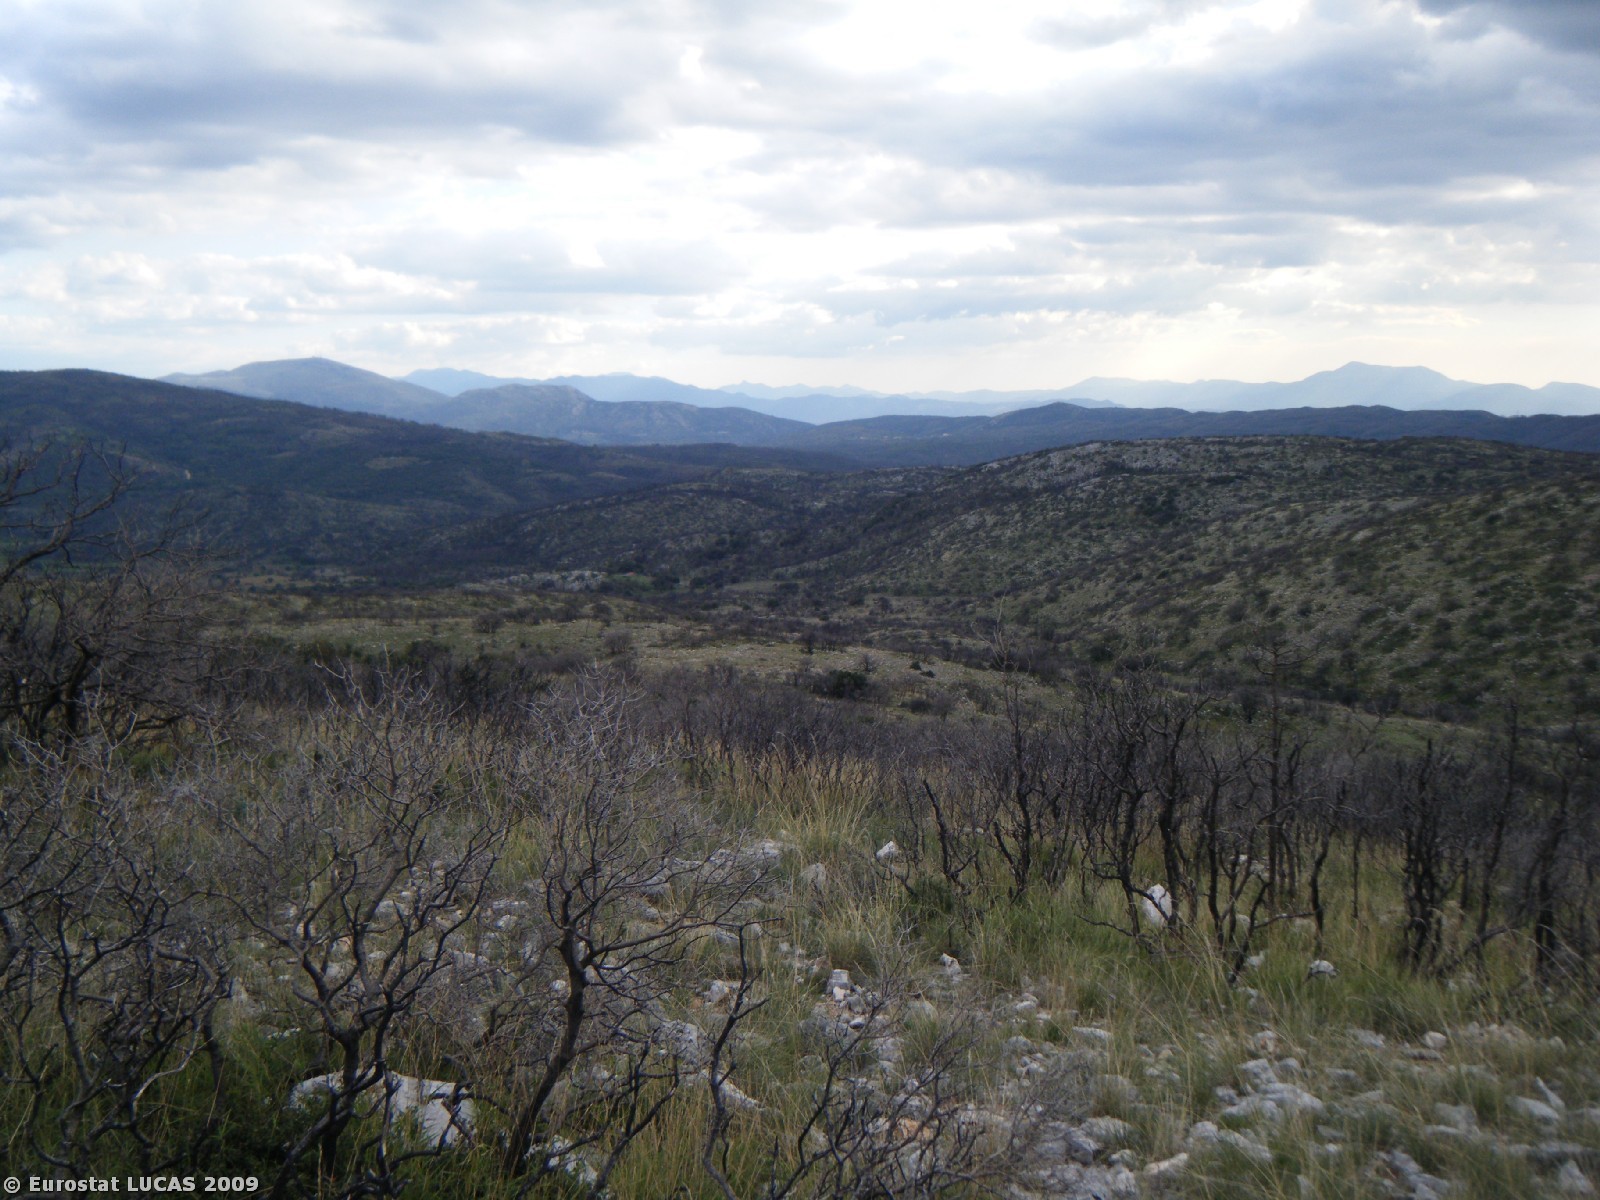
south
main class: Grassland
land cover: Grassland with sparse tree/shrub cover
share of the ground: 50 - 75 %
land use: Unused
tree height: < 5 m
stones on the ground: 25 - 50 %
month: October
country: GR
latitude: 37.4682
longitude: 22.2281
